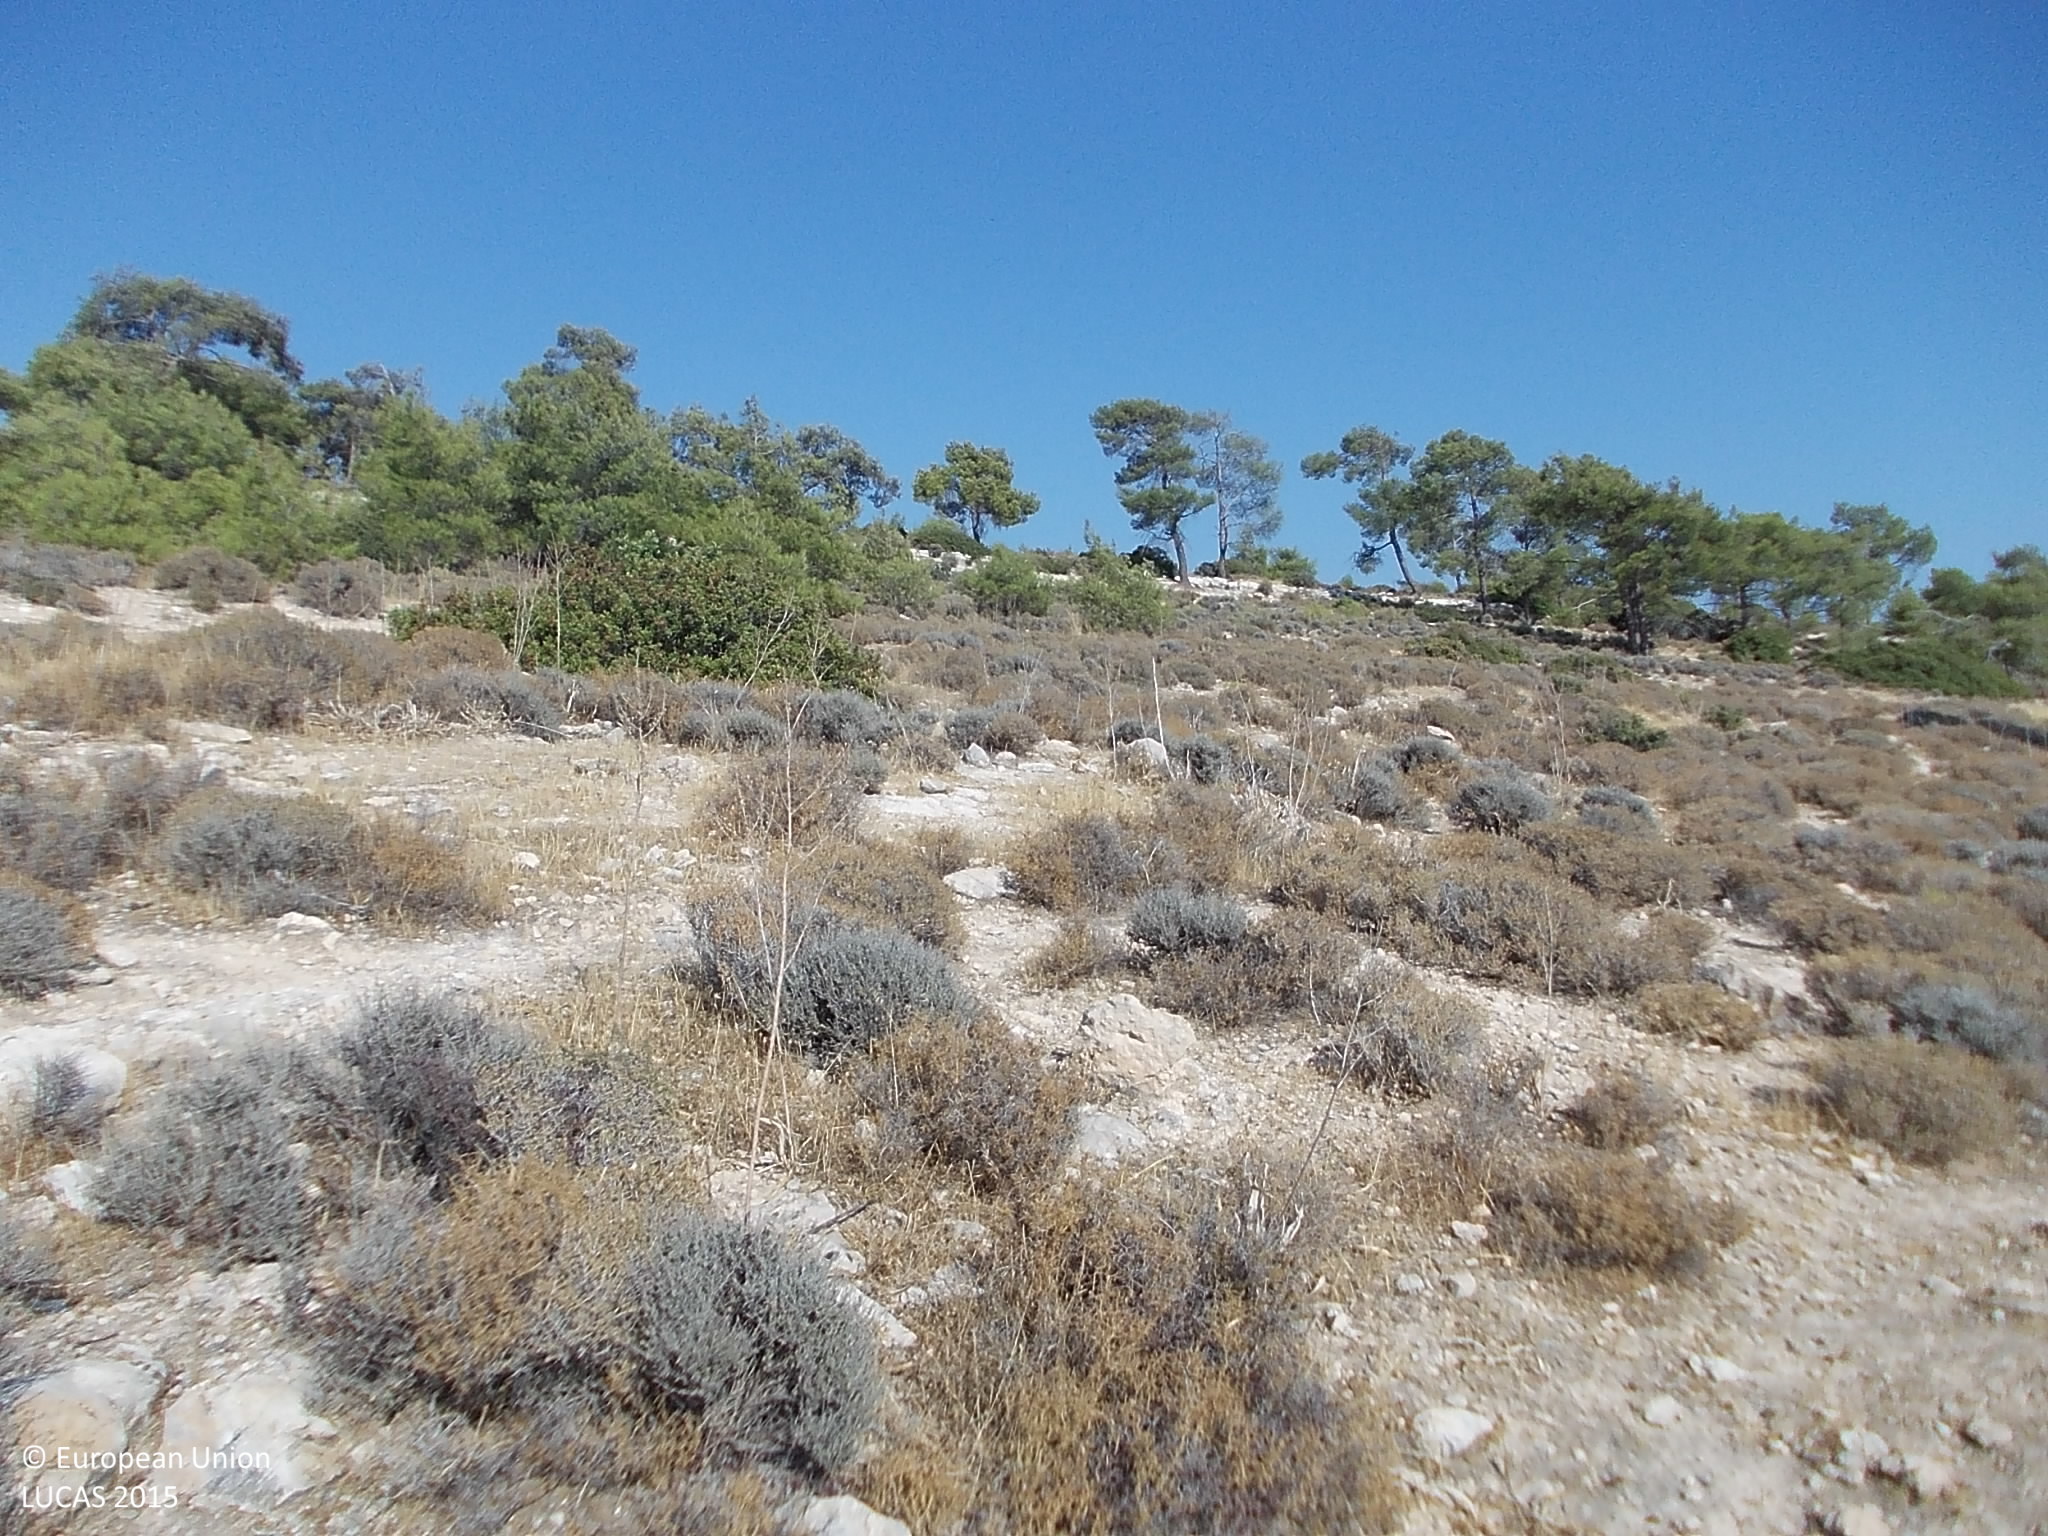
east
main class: Shrubland
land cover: Shrubland without tree cover
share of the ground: 50 - 75 %
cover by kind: shrubs 55 %, unconsolidated bare surface 25 %, herbaceous plants 15 %, consolidated bare surface 5 %
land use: Semi-natural and natural areas not in use
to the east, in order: Shrubland without tree cover; Pine dominated coniferous woodland; Shrubland with sparse tree cover; Pine dominated coniferous woodland; Tracks; Grassland with sparse tree/shrub cover; Other bare soil; Fences; Other bare soil; Artificial constructions in urban areas; Other bare soil; Olive groves; Other bare soil
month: August
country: CY
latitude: 34.6891
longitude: 32.8967
